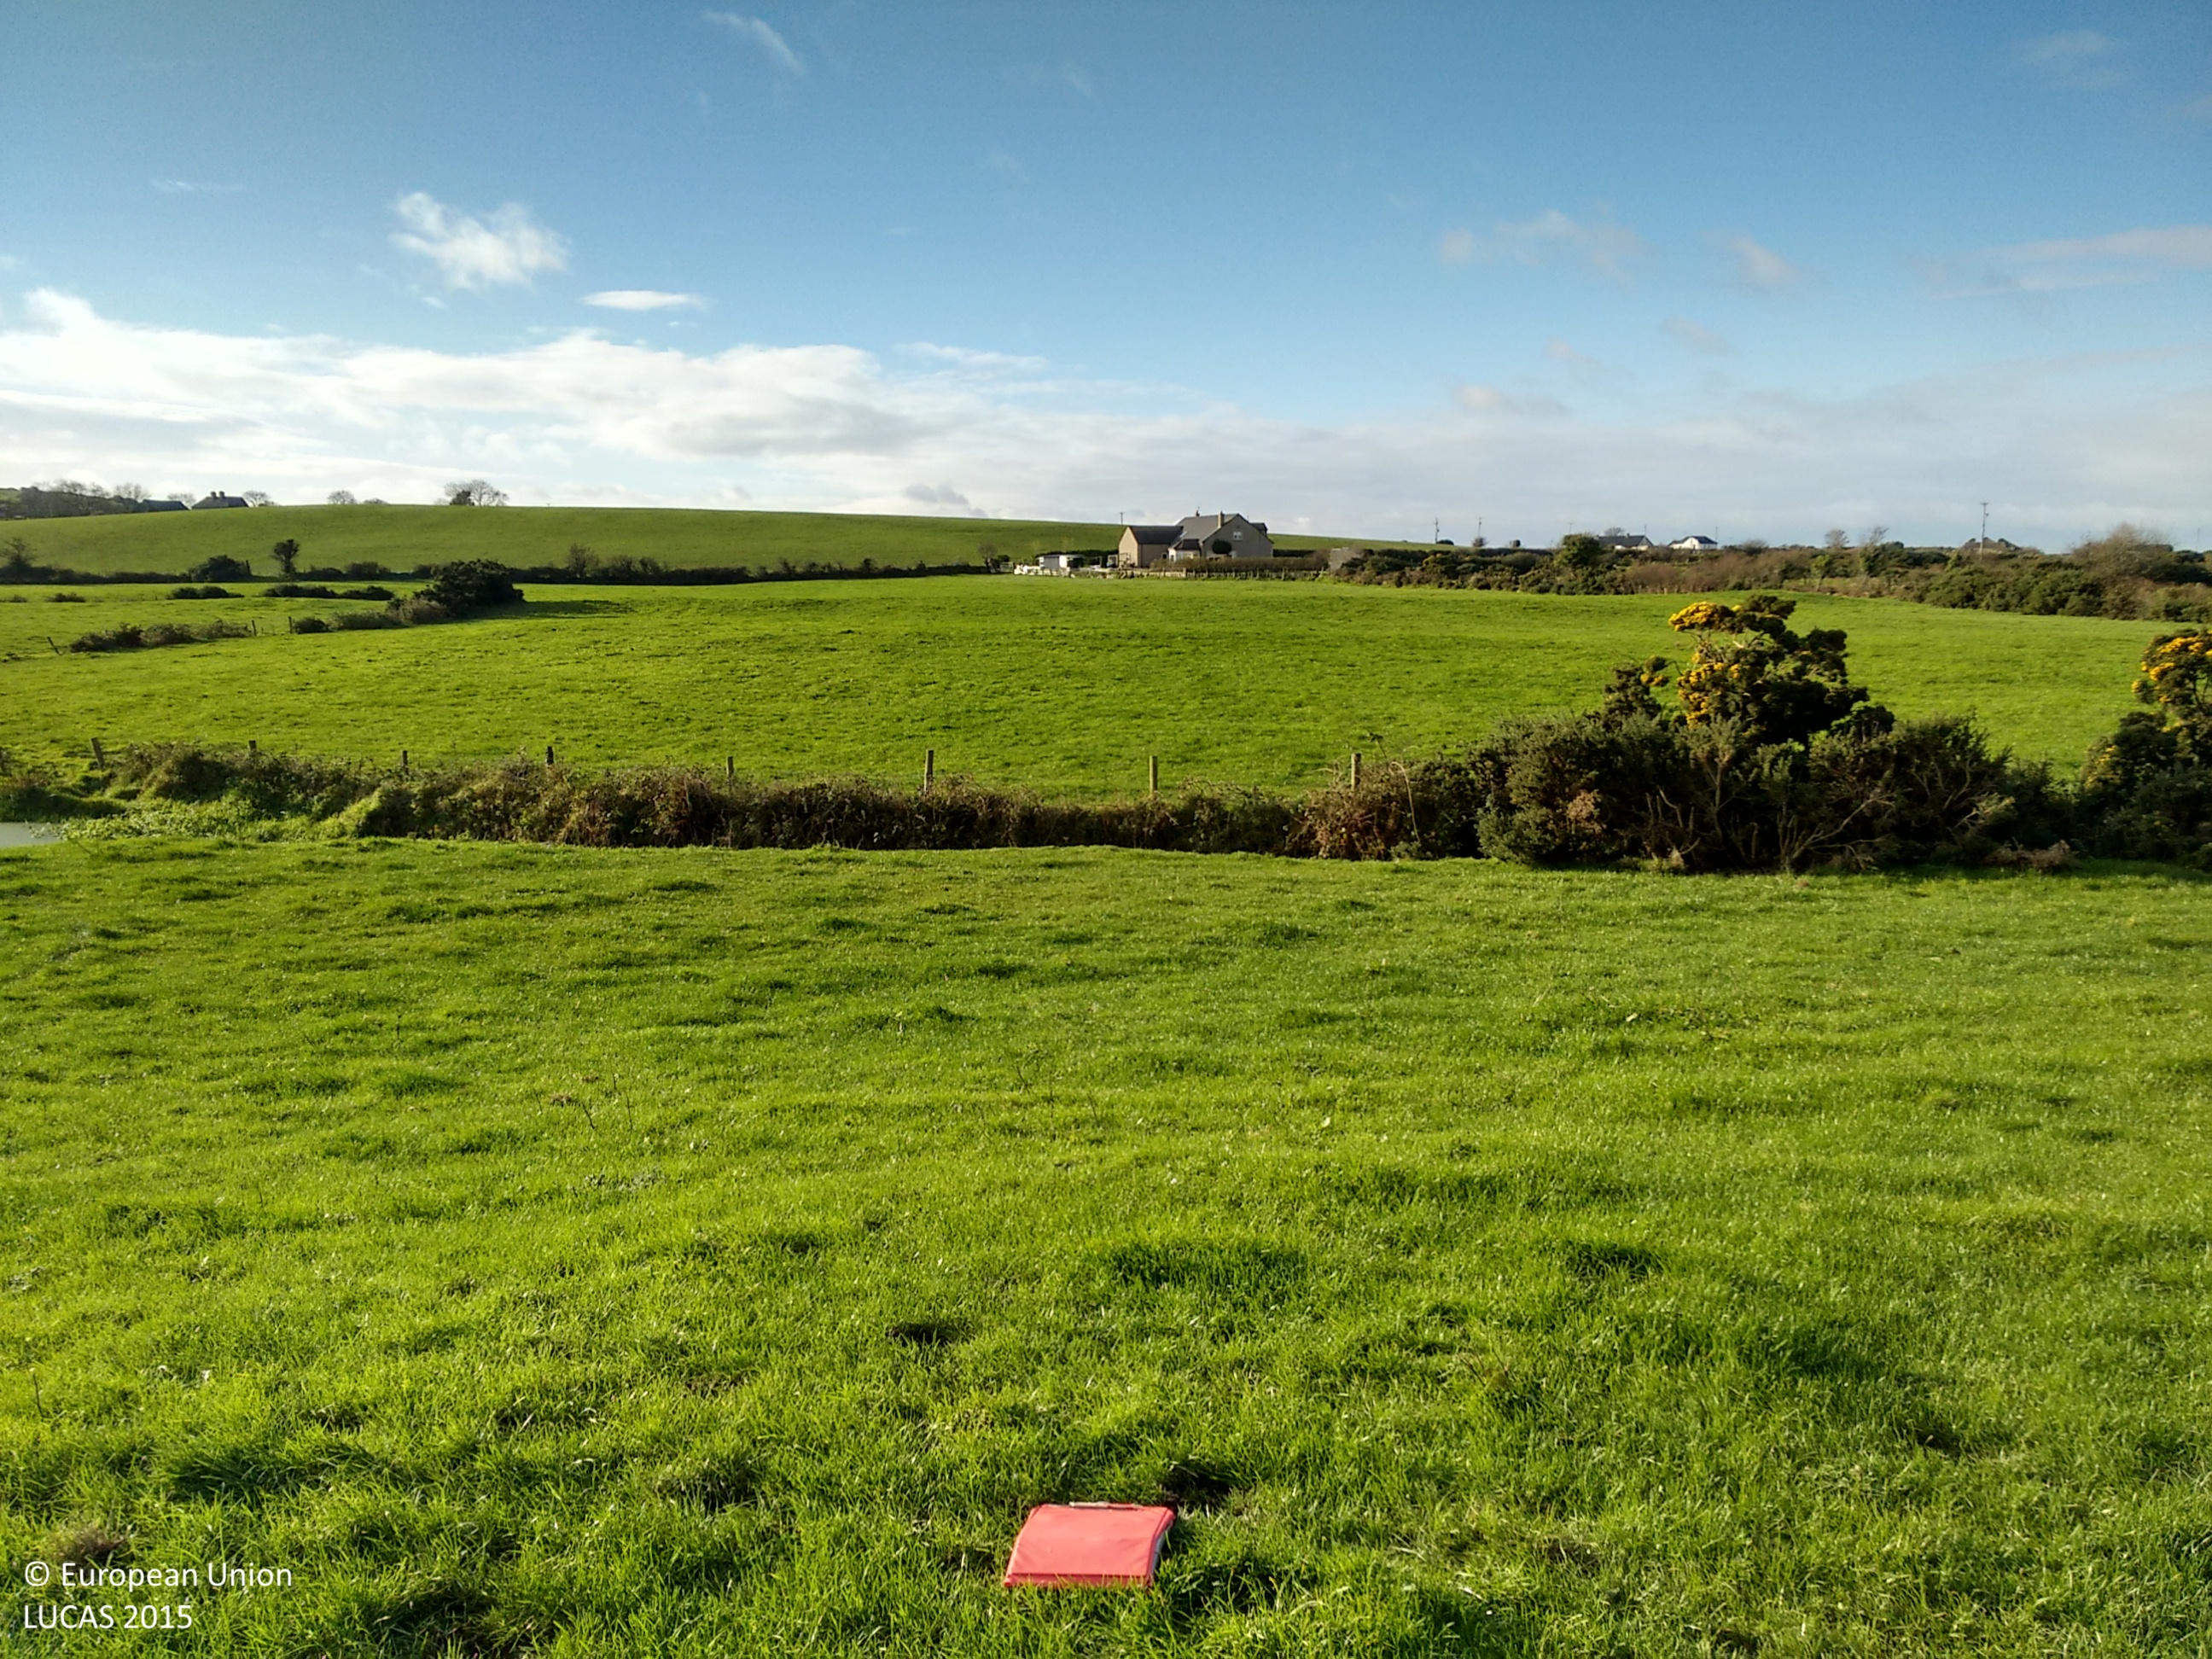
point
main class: Grassland
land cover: Grassland without tree/shrub cover
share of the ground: > 75 %
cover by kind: herbaceous plants 100 %
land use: Agriculture (excluding fallow land and kitchen gardens)
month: November
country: GB
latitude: 54.4269
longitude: -5.5267
